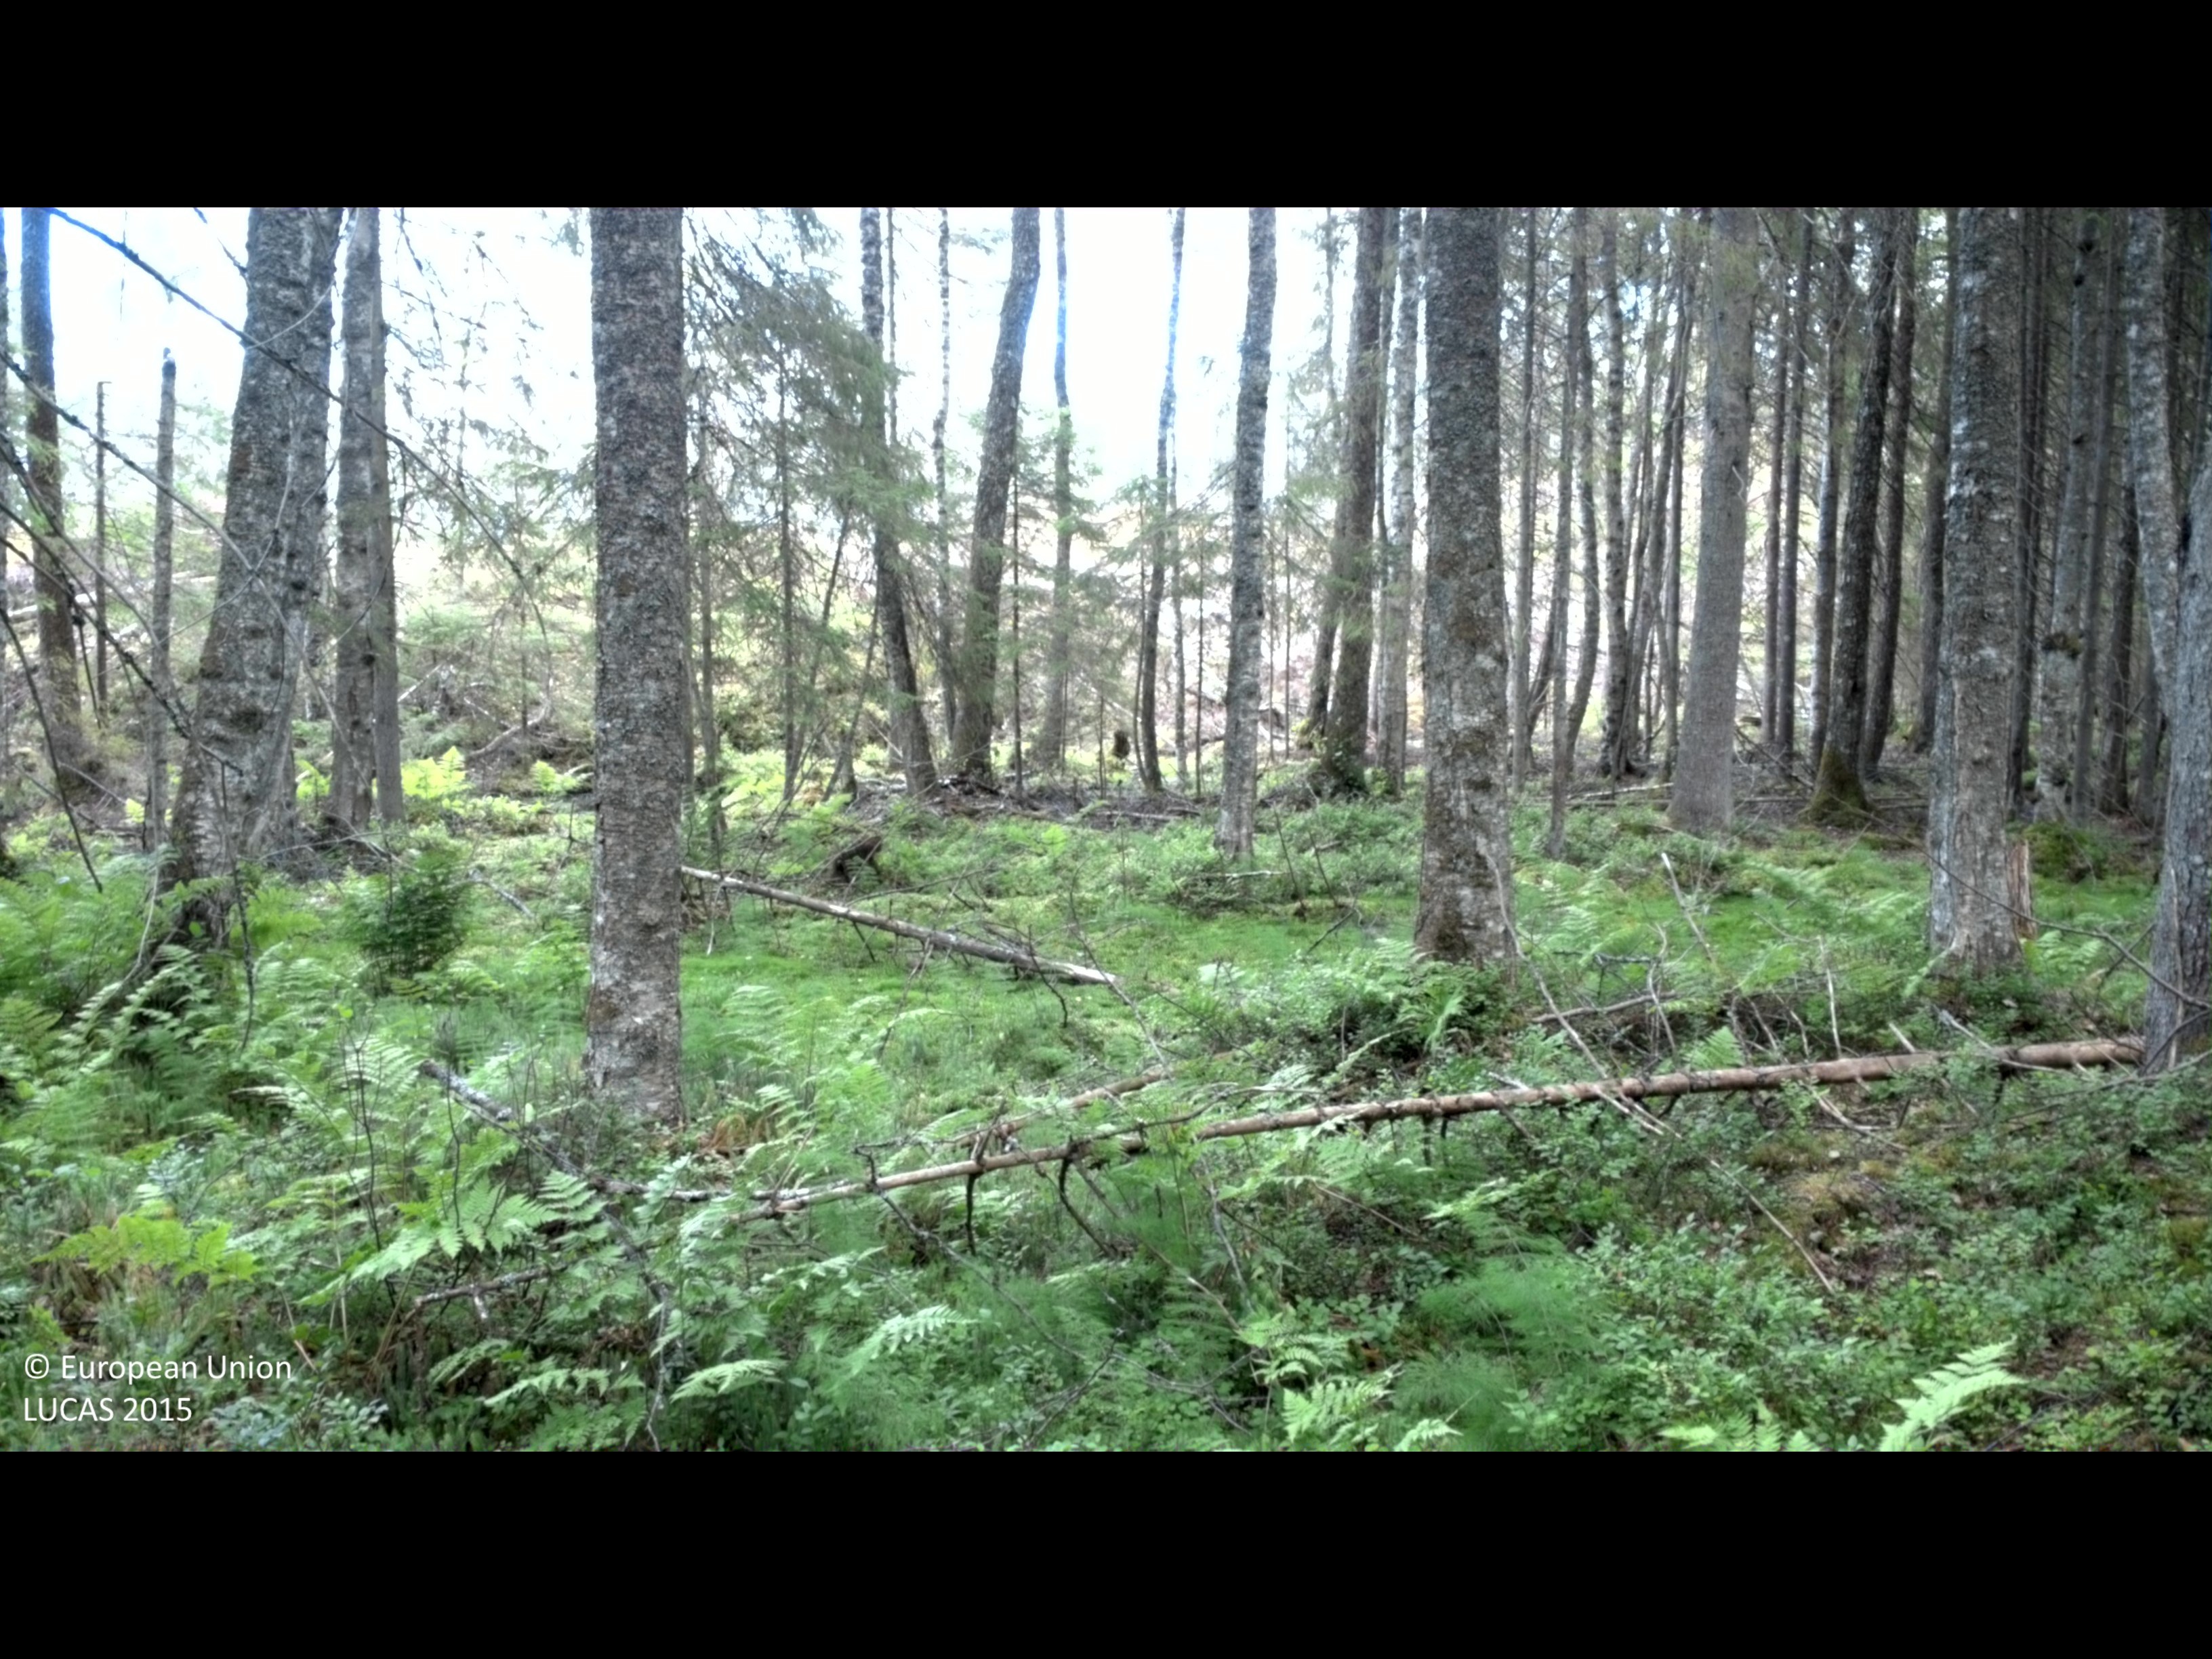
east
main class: Woodland
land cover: Spruce dominated mixed woodland
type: mire and swamp forests
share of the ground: 50 - 75 %
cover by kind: coniferous forest trees 35 %, broadleaved forest trees 25 %, shrubs 15 %, lichens and mosses 15 %, herbaceous plants 10 %
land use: Forestry
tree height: > 5 m
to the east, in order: Spruce dominated mixed woodland; Other bare soil; Pine dominated coniferous woodland; Broadleaved woodland; Spruce dominated mixed woodland; Spruce dominated coniferous woodland; Spruce dominated mixed woodland
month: July
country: SE
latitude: 57.9549
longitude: 16.0970
